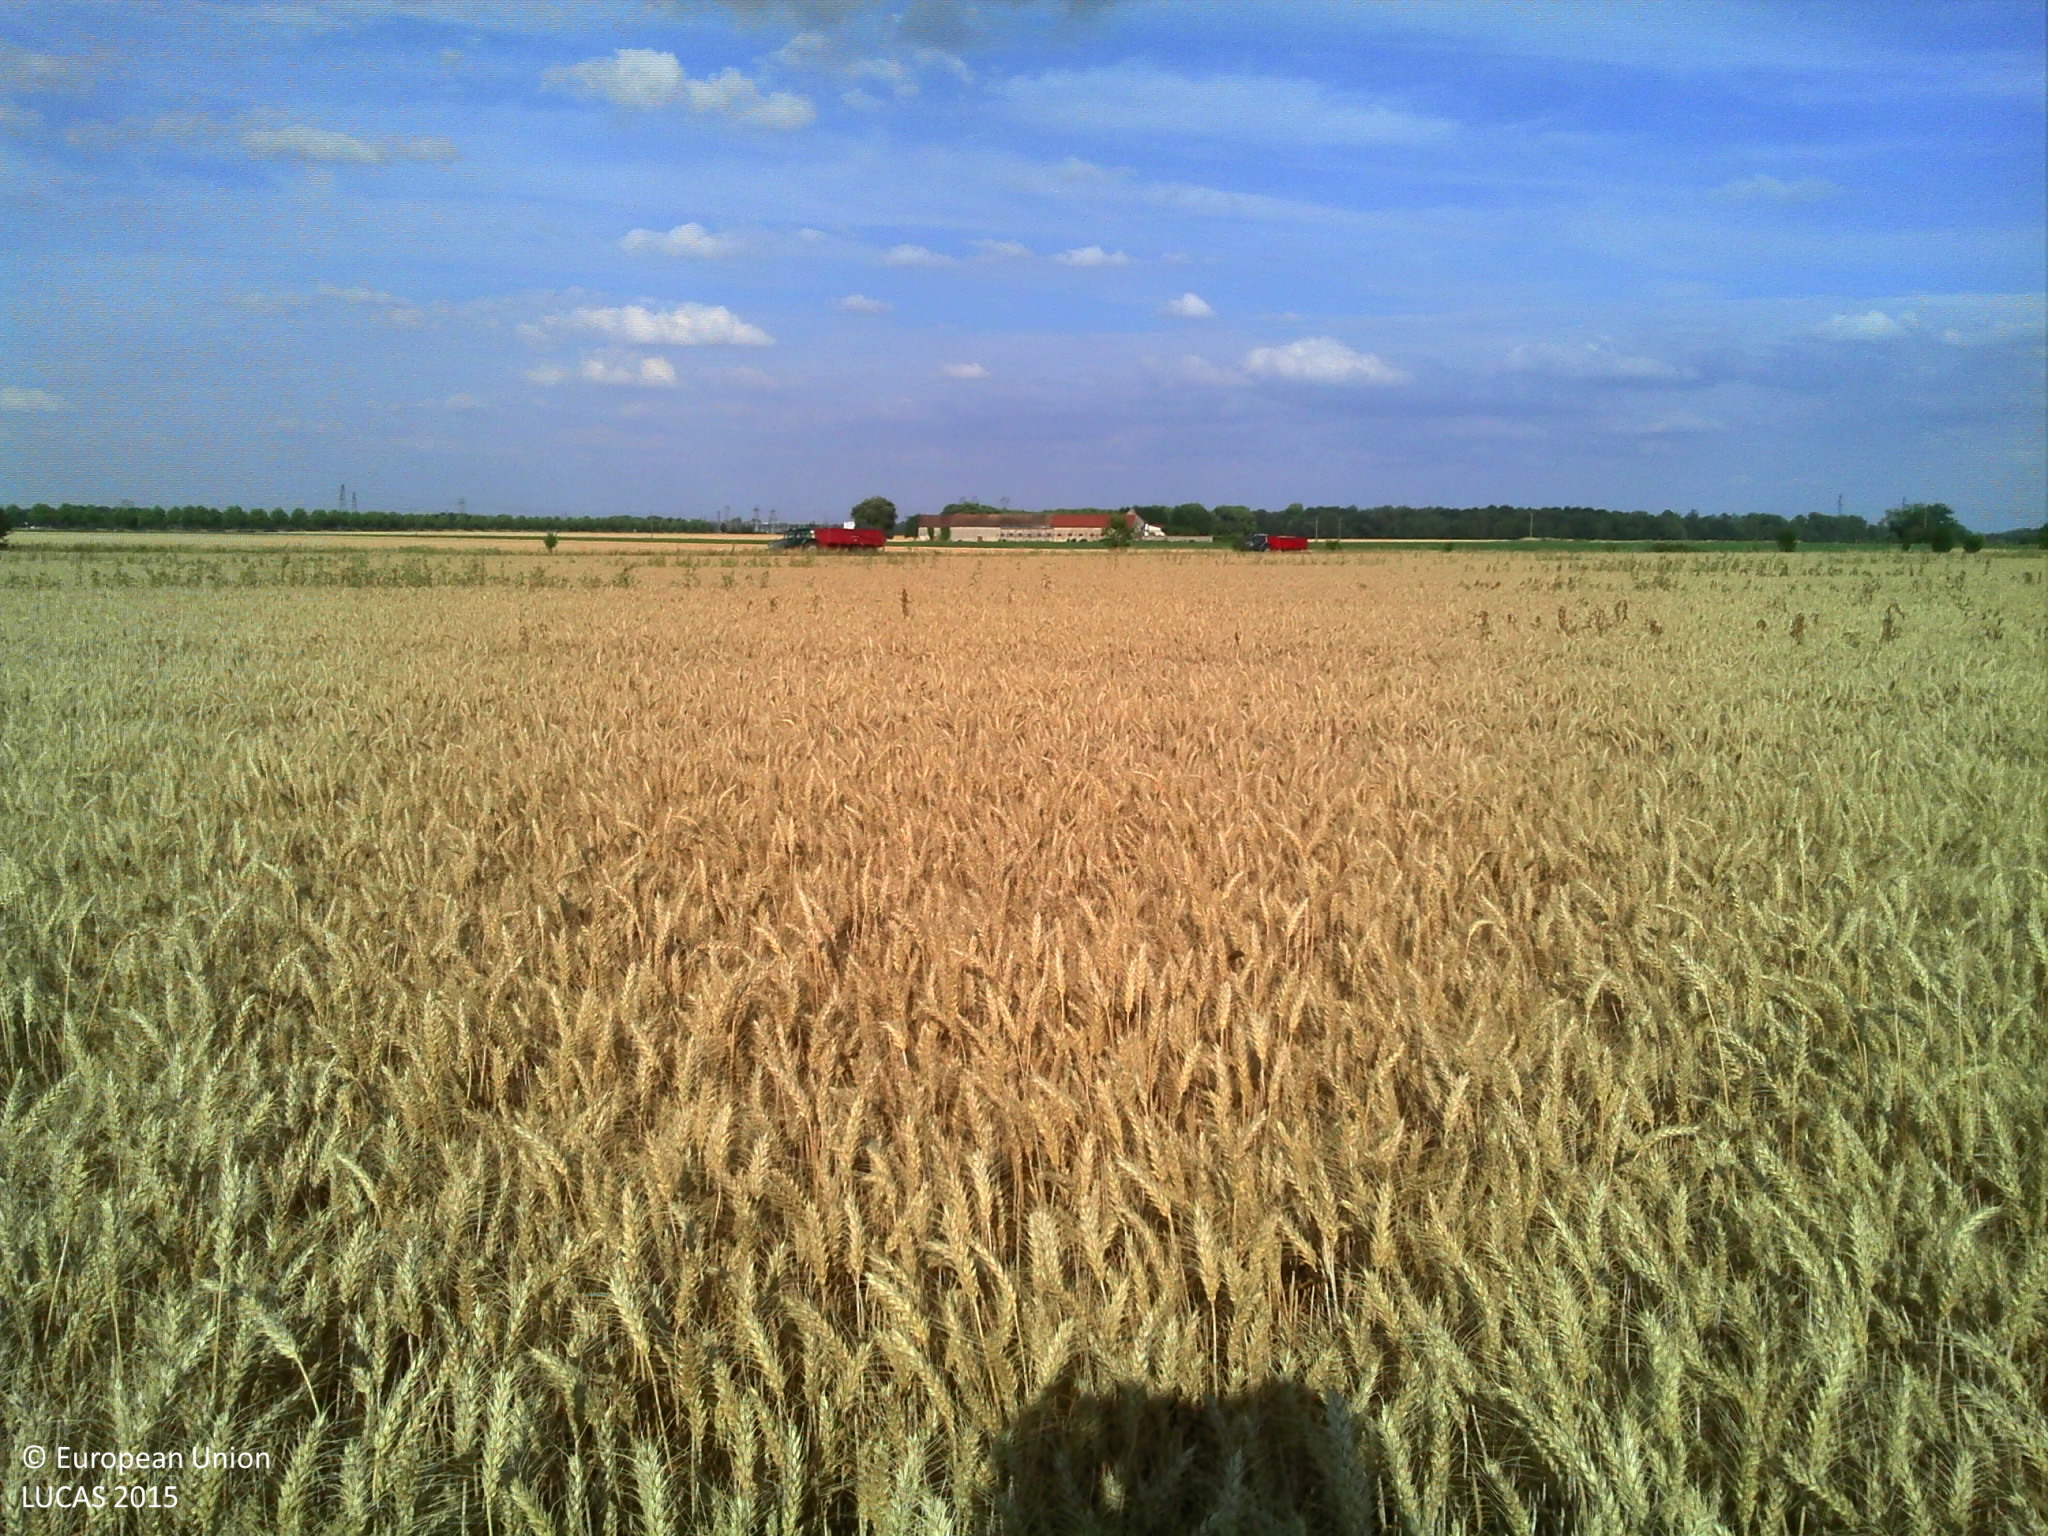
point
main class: Cropland
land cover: Common wheat
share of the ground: > 75 %
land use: Agriculture (excluding fallow land and kitchen gardens)
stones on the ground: < 10 %
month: July
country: FR
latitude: 48.5443
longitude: 2.7437
